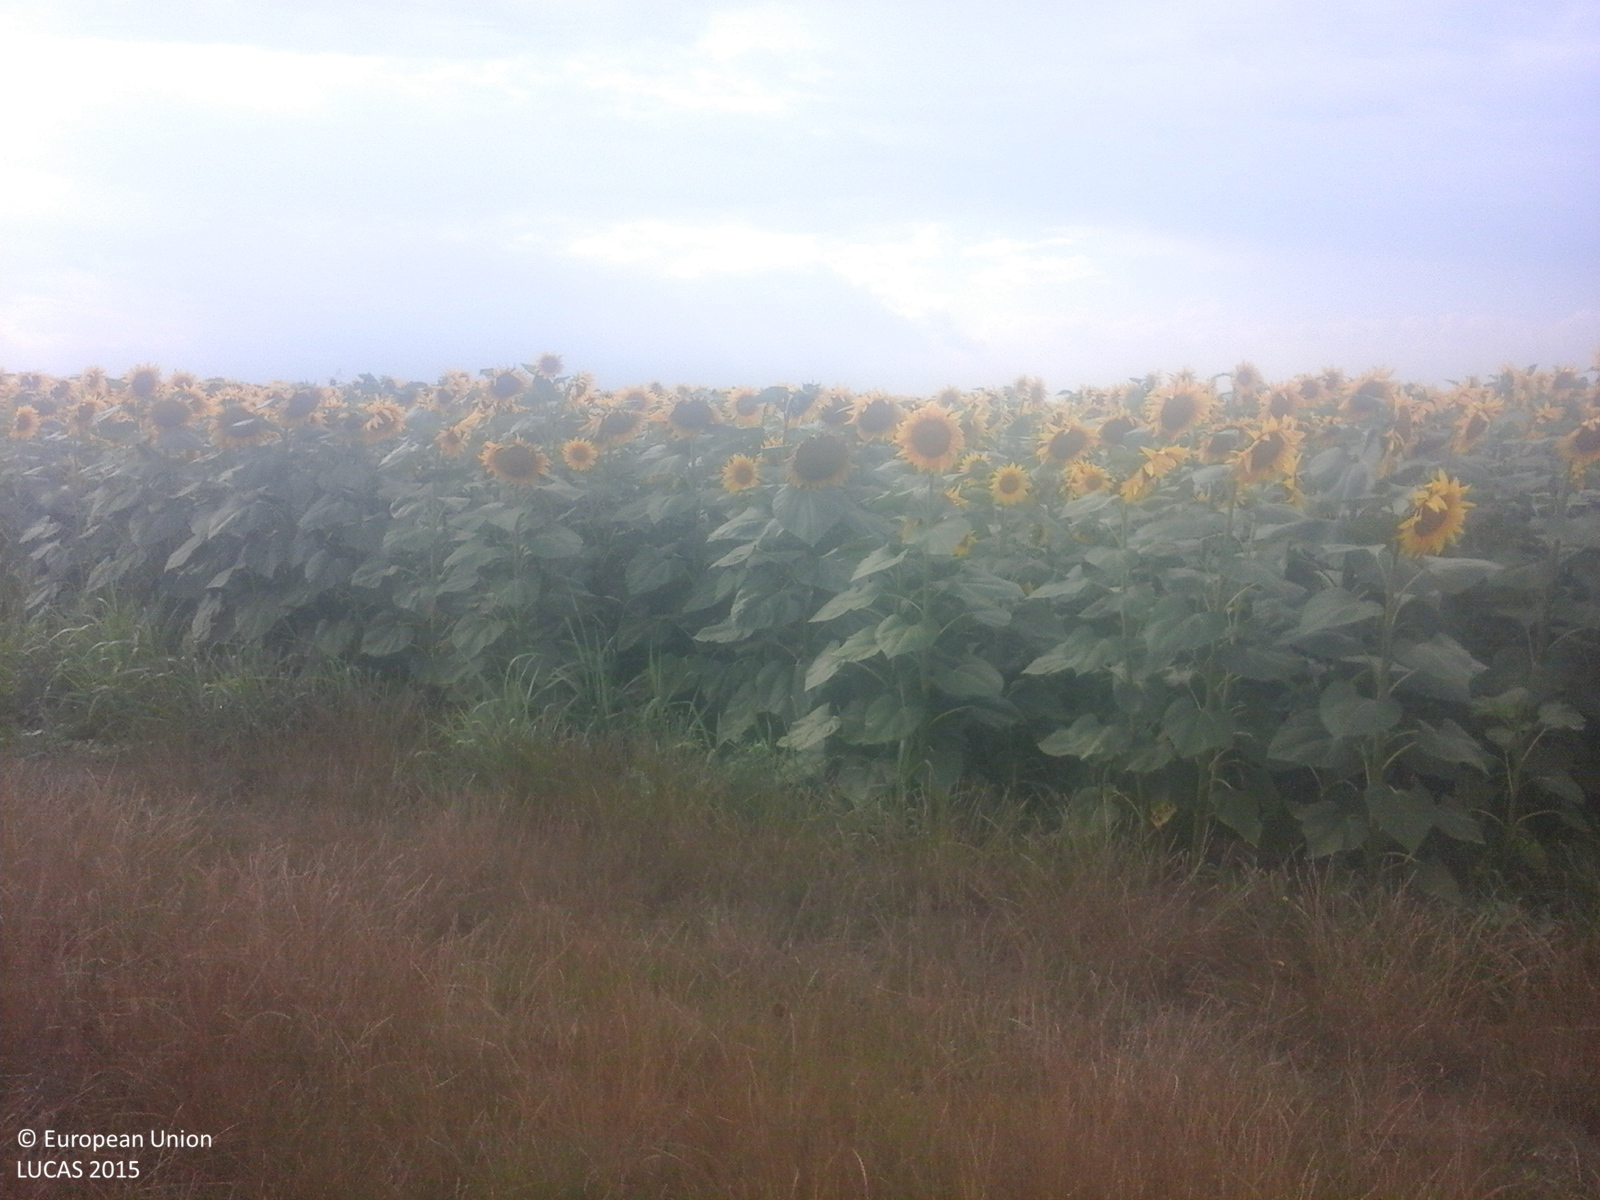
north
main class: Cropland
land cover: Common wheat
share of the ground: > 75 %
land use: Agriculture (excluding fallow land and kitchen gardens)
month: July
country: RO
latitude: 43.7602
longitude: 24.6619
